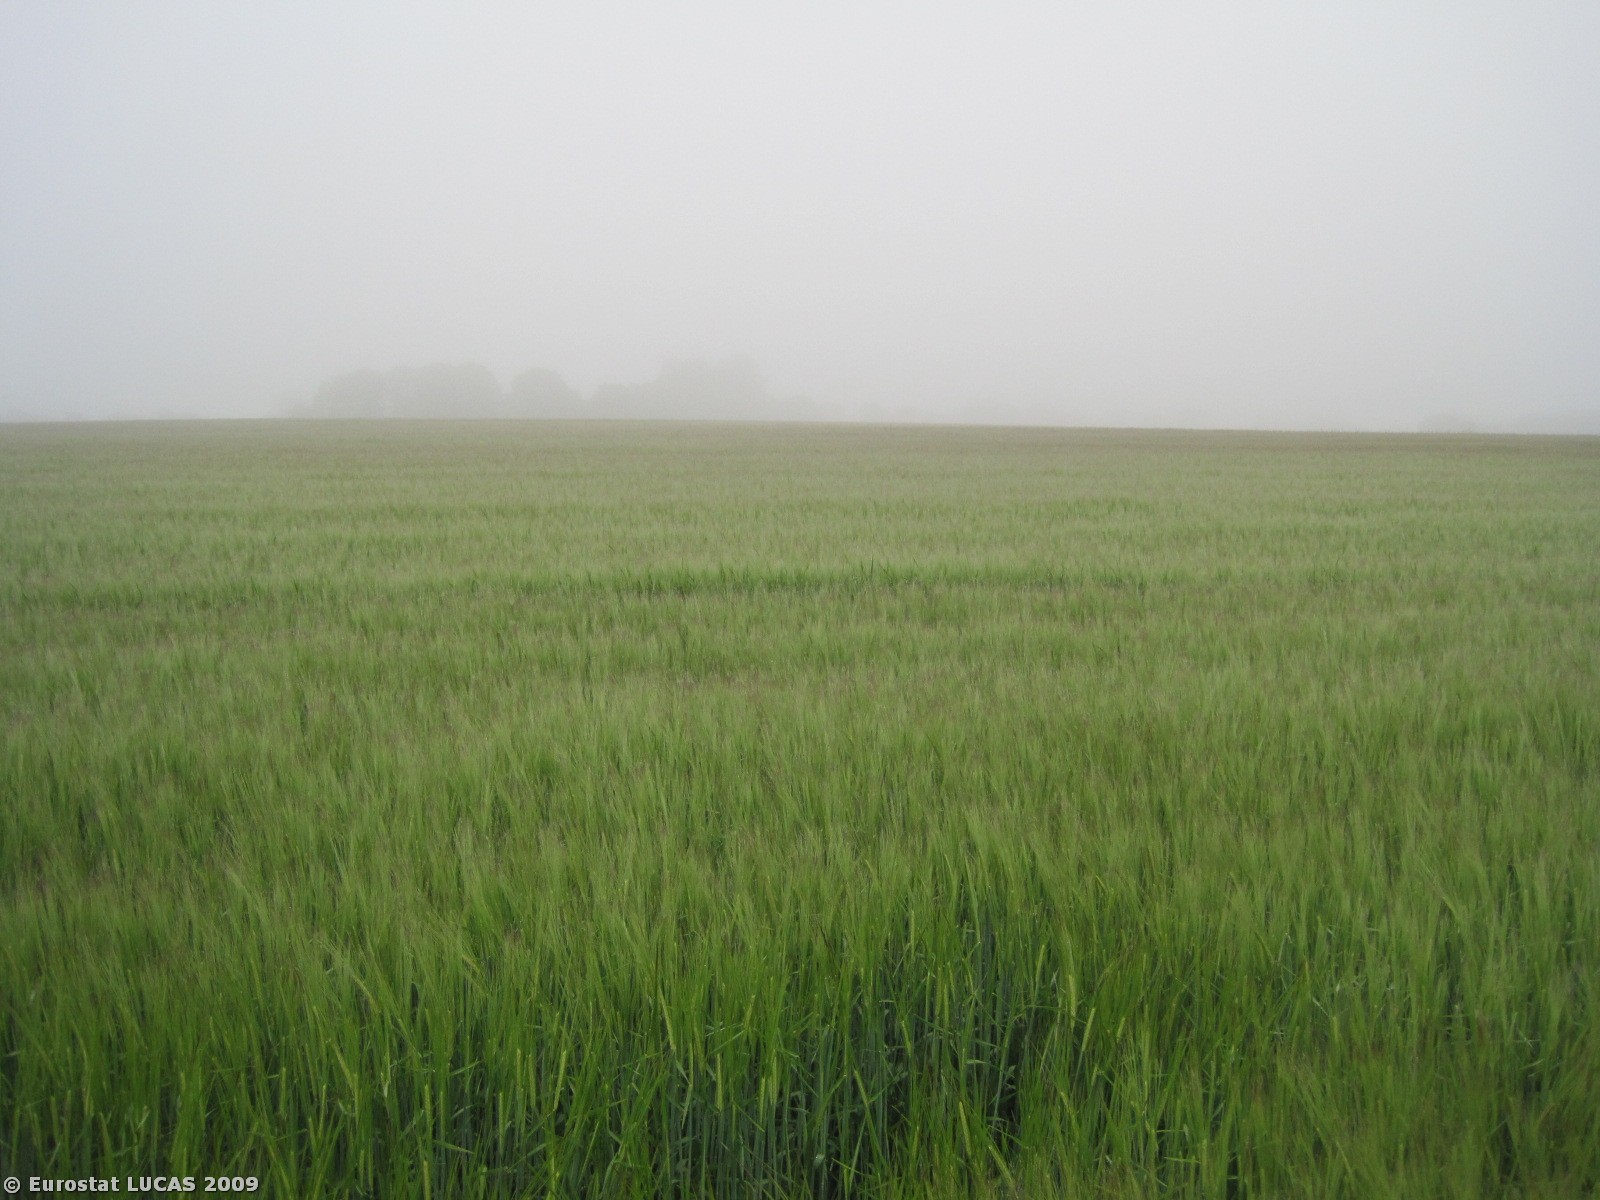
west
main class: Cropland
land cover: Barley
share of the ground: > 75 %
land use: Agriculture (excluding fallow land and kitchen gardens)
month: June
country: DK
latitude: 56.4893
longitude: 8.9781
